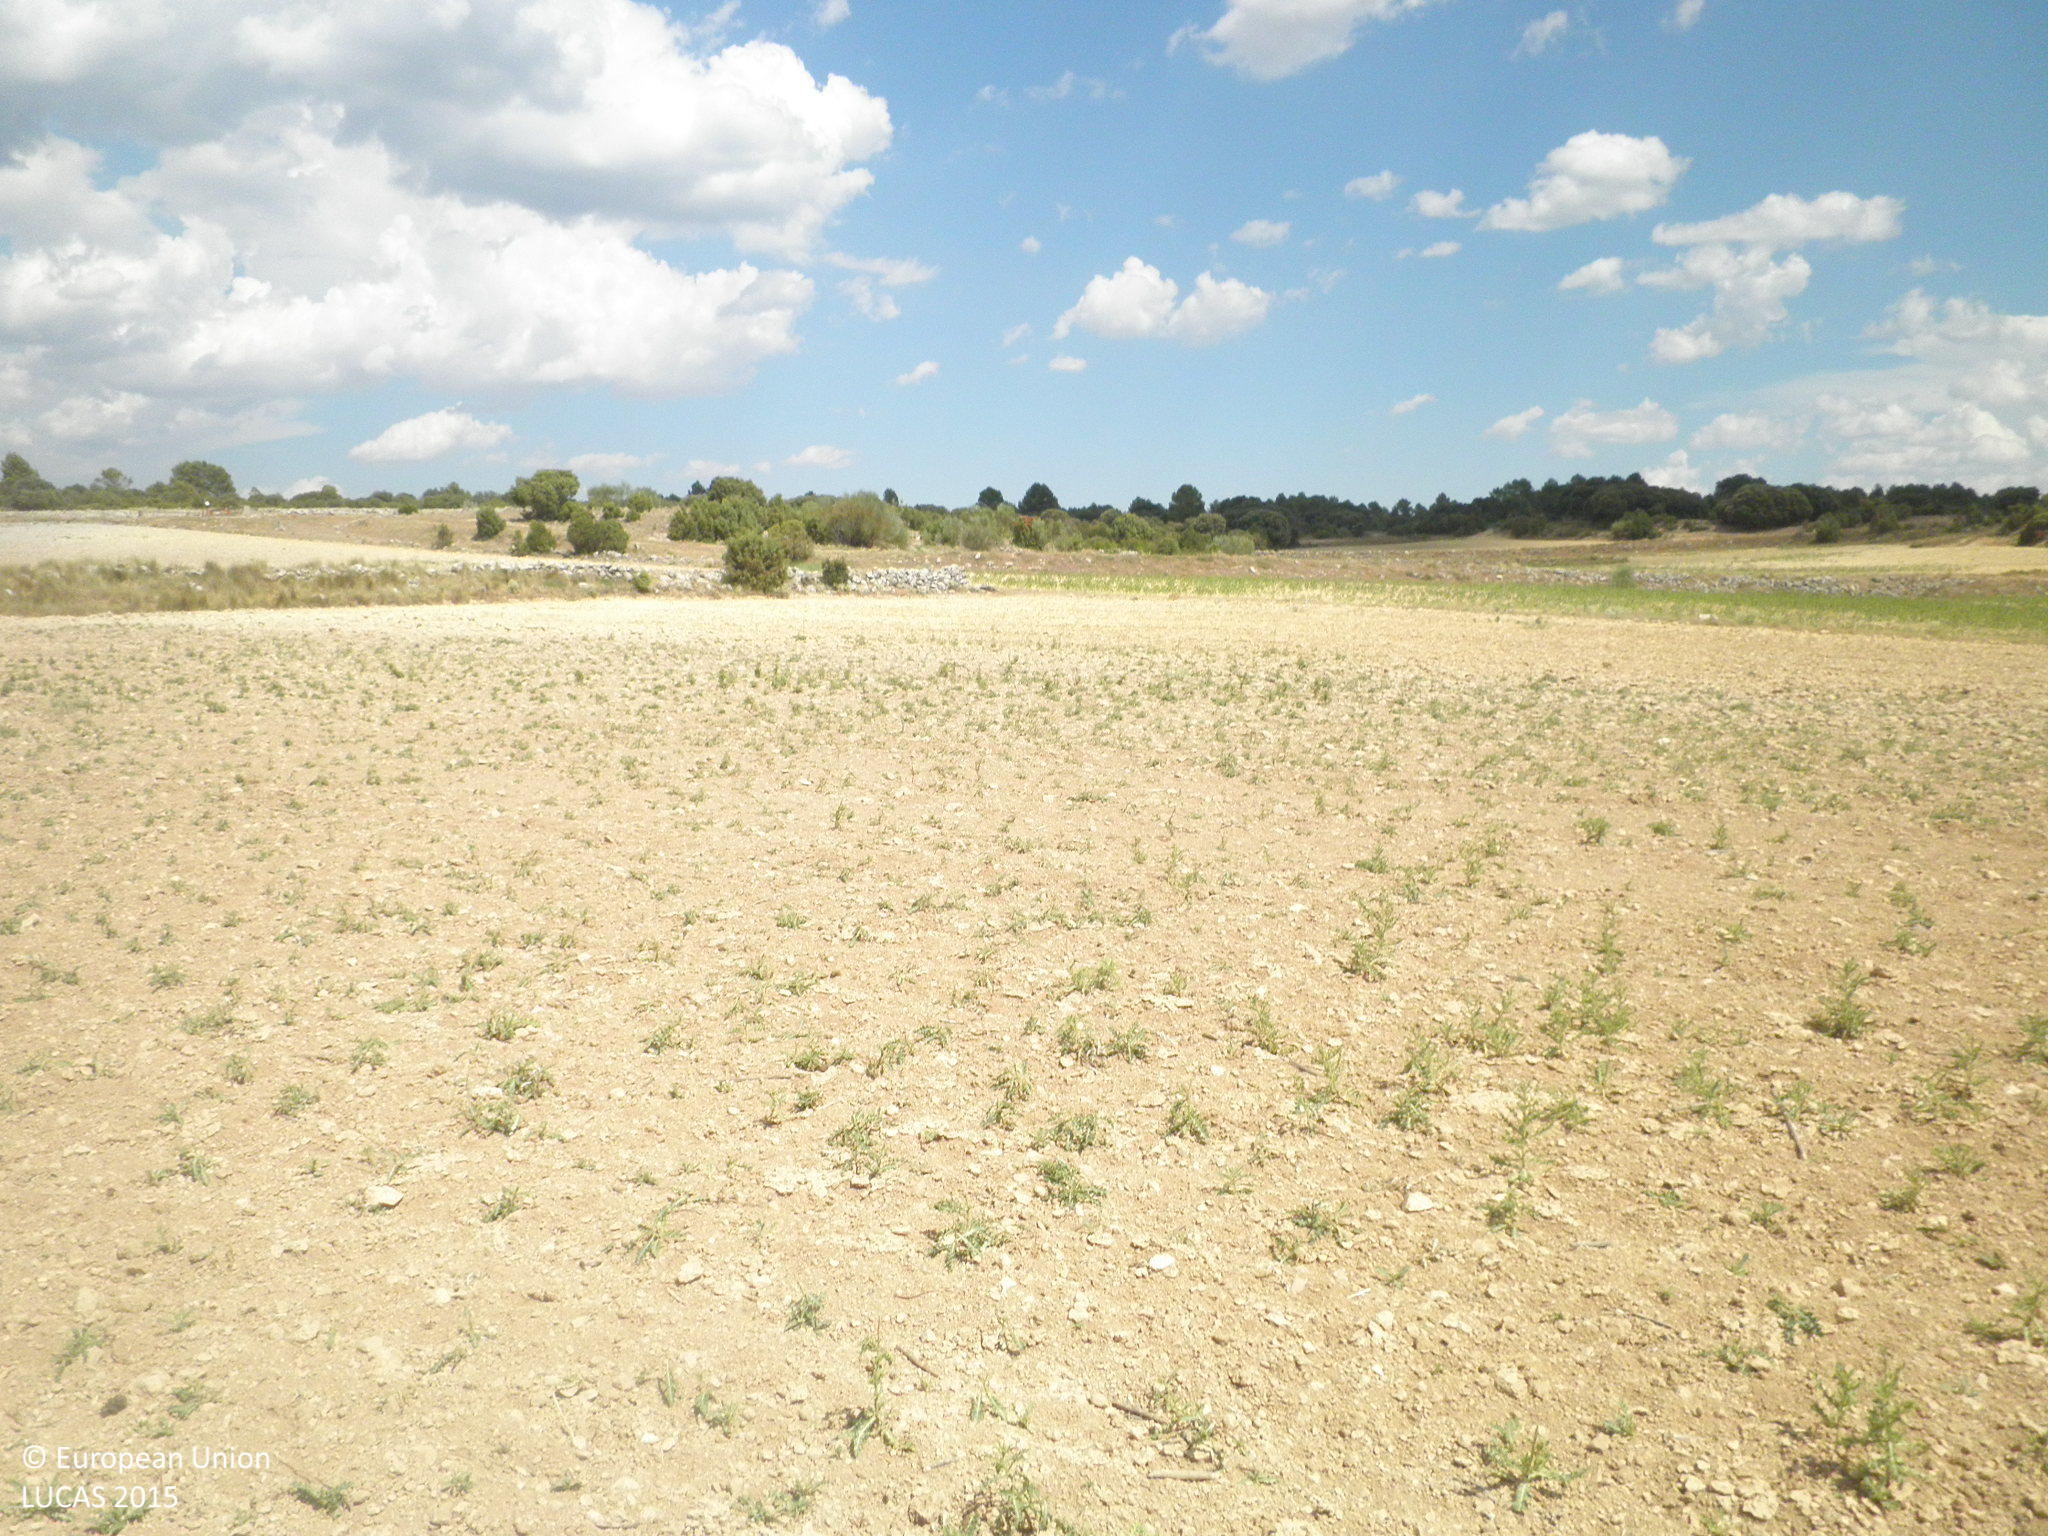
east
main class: Grassland
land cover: Spontaneously vegetated surfaces
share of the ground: 10 - 25 %
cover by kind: unconsolidated bare surface 90 %, herbaceous plants 10 %
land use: Fallow land
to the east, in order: Spontaneously vegetated surfaces; Grass margins; Dry stone walls; Other bare soil; Grass margins; Dry stone walls; Tracks; Shrubland without tree cover; Grassland without tree/shrub cover; Tracks; Grassland without tree/shrub cover; Shrubland with sparse tree cover
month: July
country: ES
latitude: 39.6413
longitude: -1.6711
